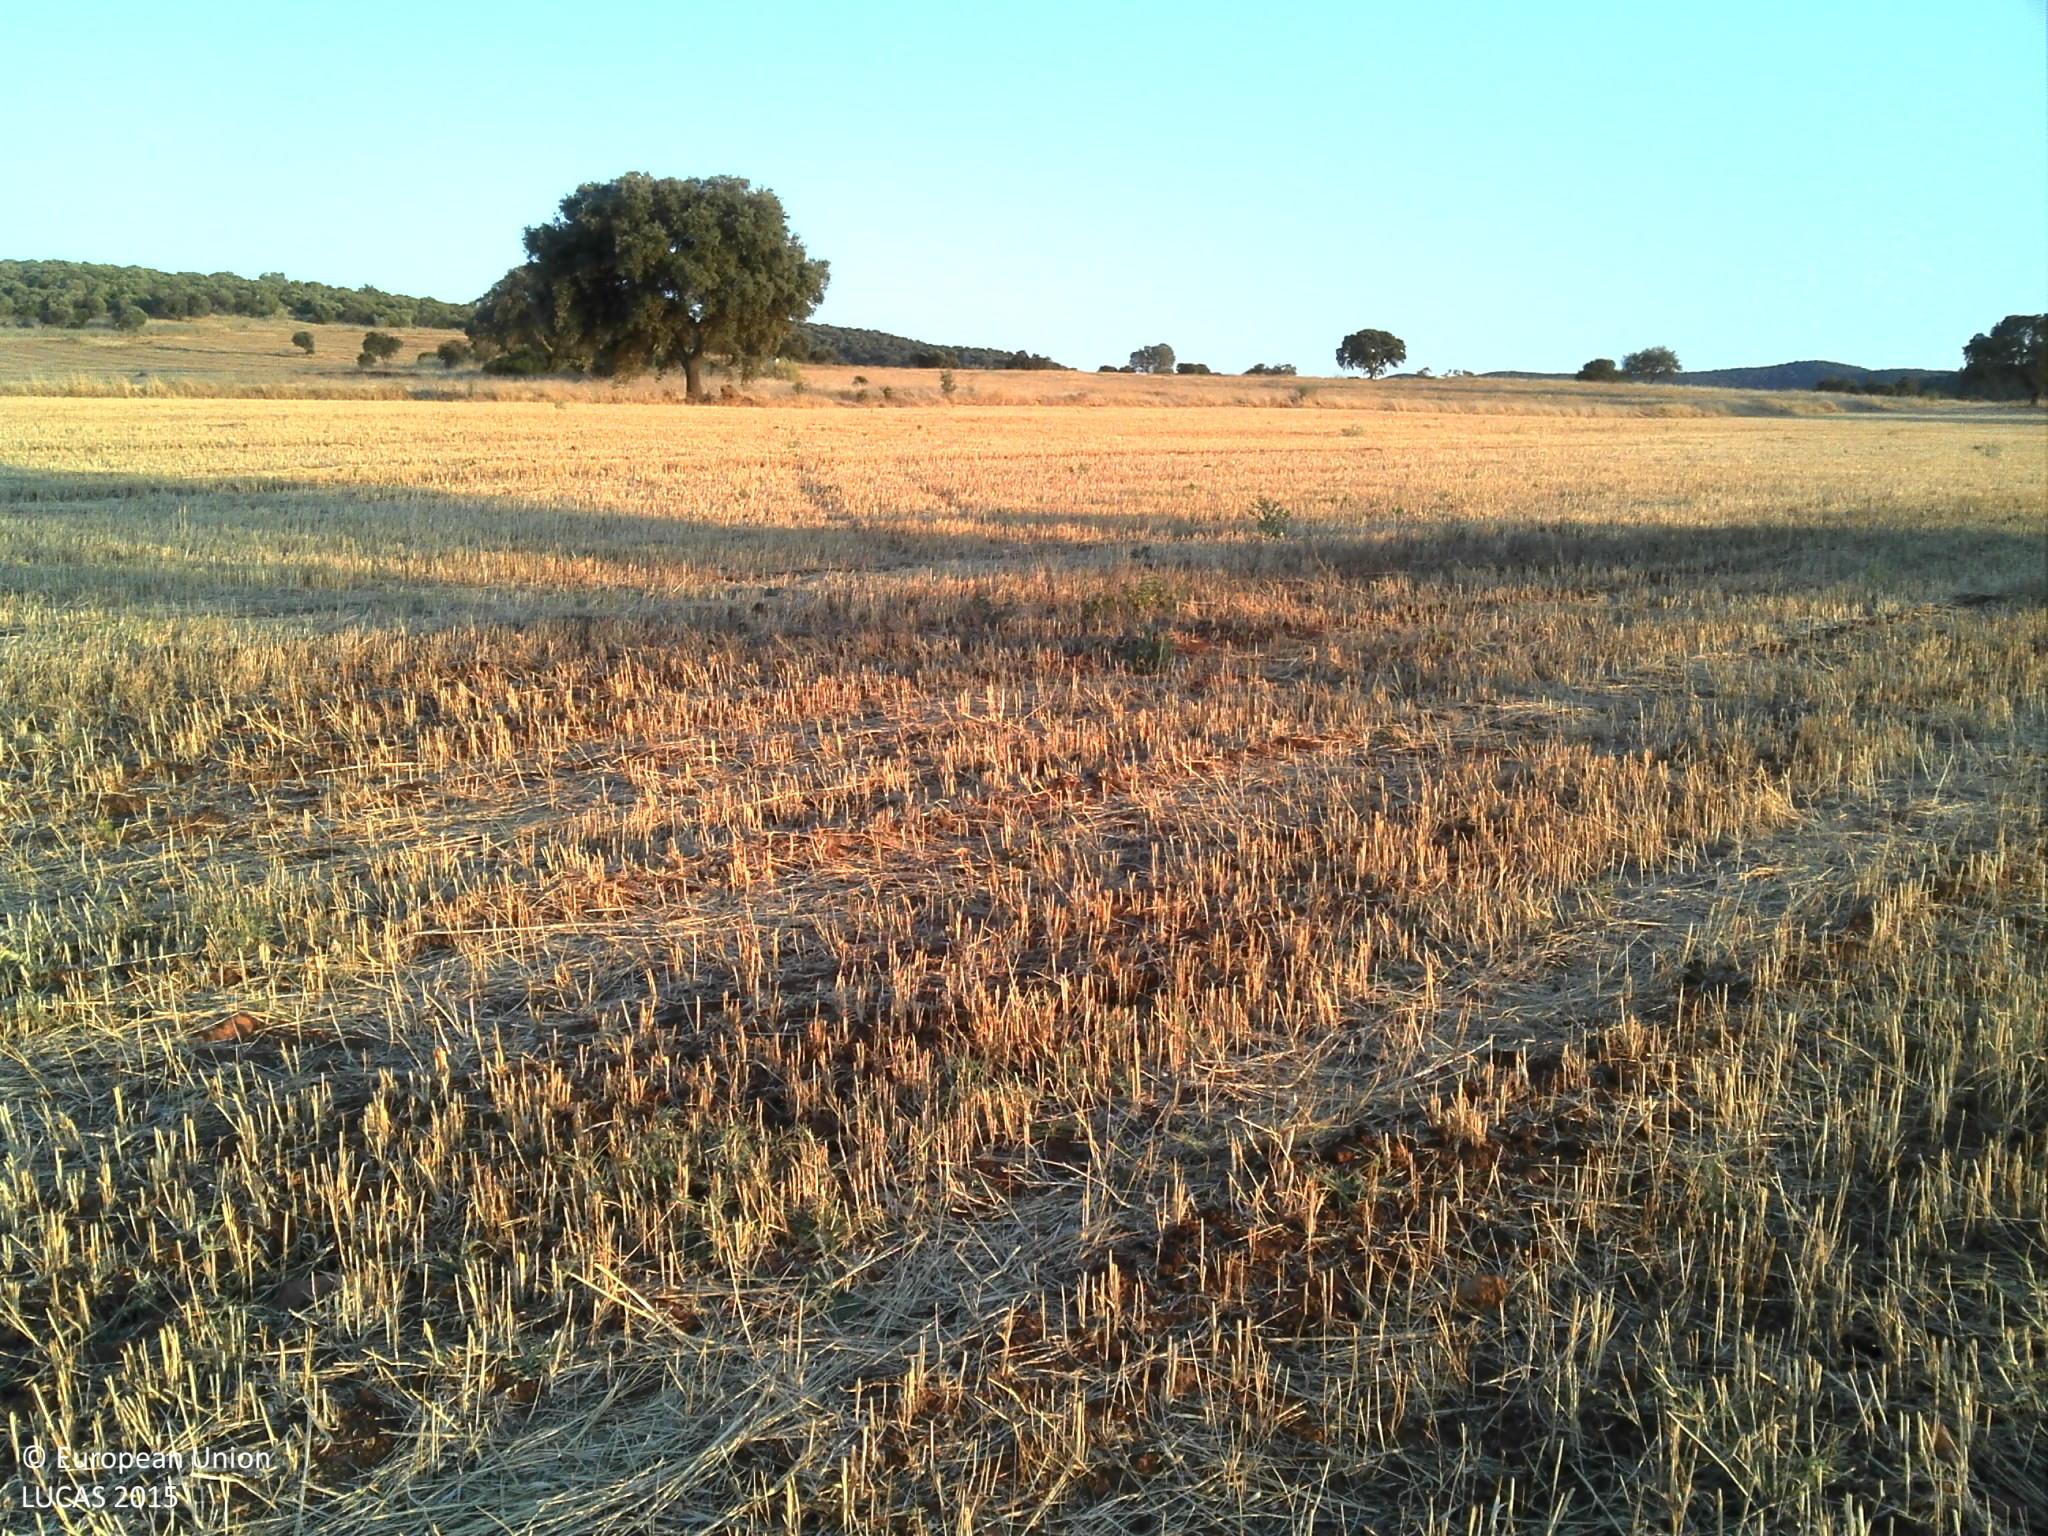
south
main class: Cropland
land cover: Barley
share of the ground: > 75 %
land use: Agriculture (excluding fallow land and kitchen gardens)
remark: Harvested field
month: July
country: PT
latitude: 38.0790
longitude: -7.3572
